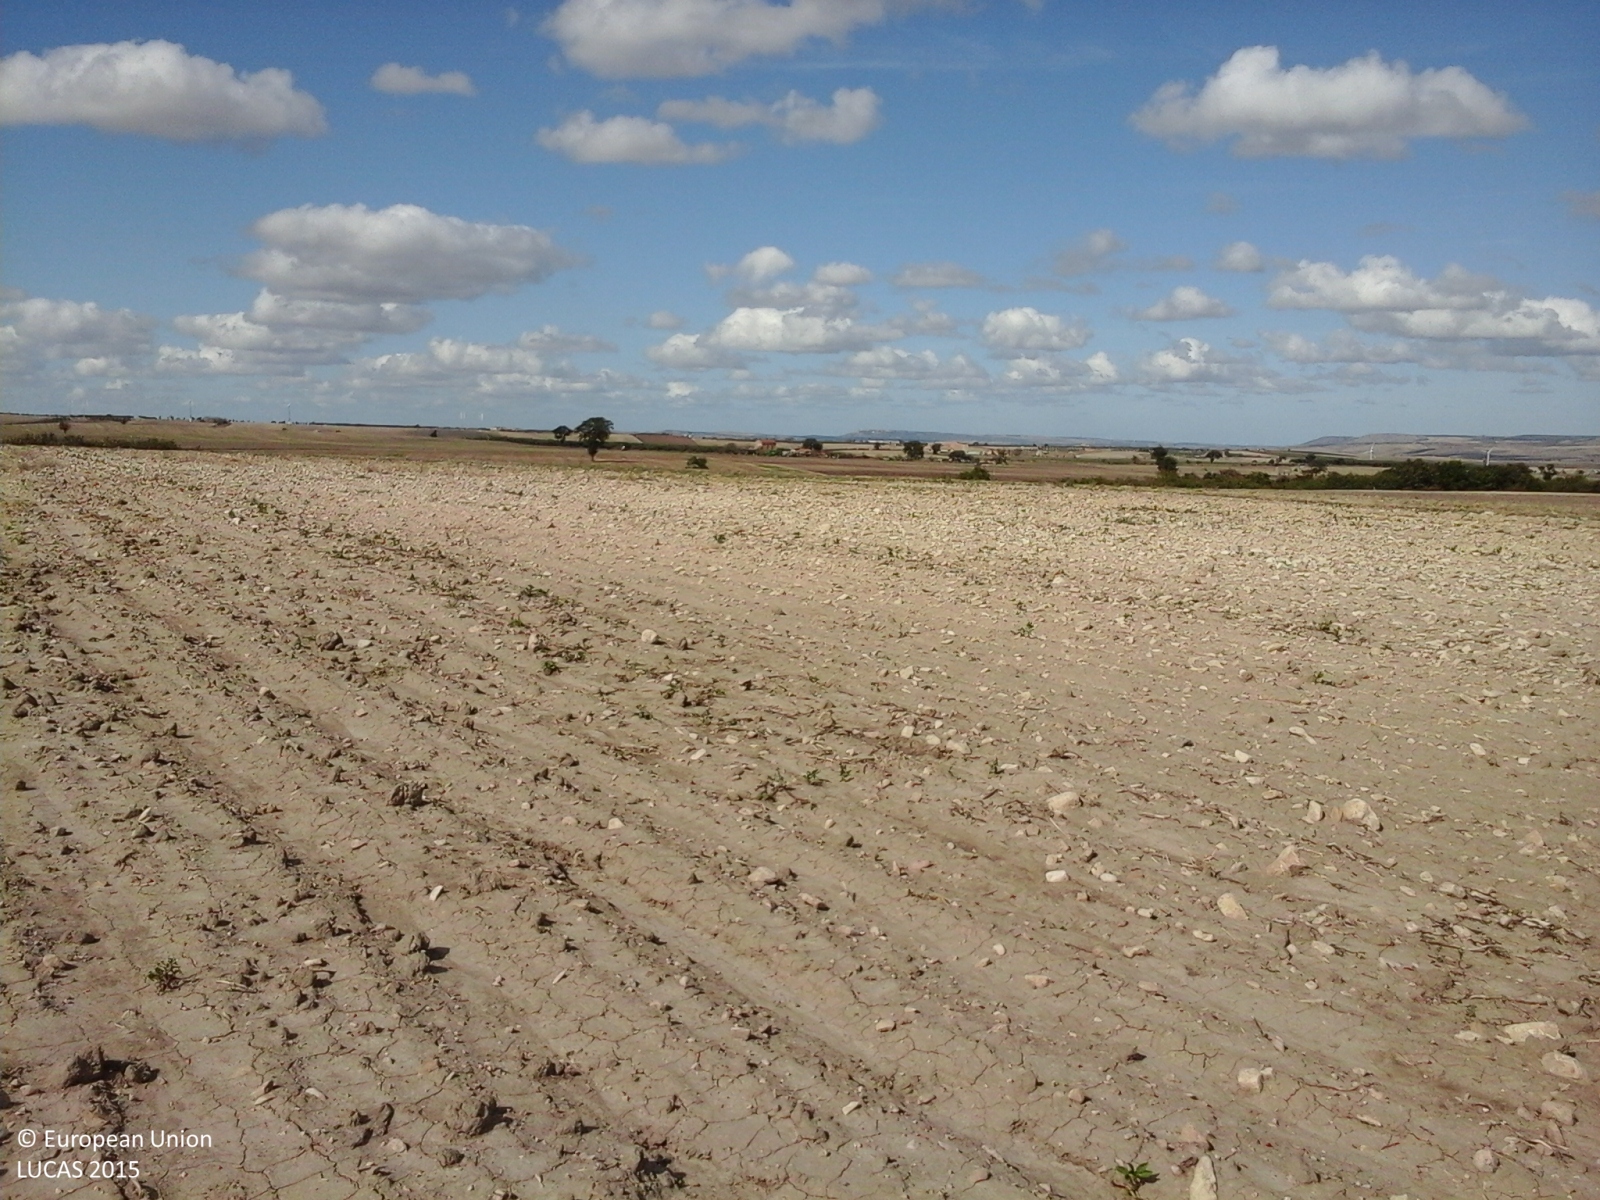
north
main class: Cropland
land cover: Dry pulses
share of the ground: > 75 %
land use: Agriculture (excluding fallow land and kitchen gardens)
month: September
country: IT
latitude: 41.5984
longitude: 15.1780
